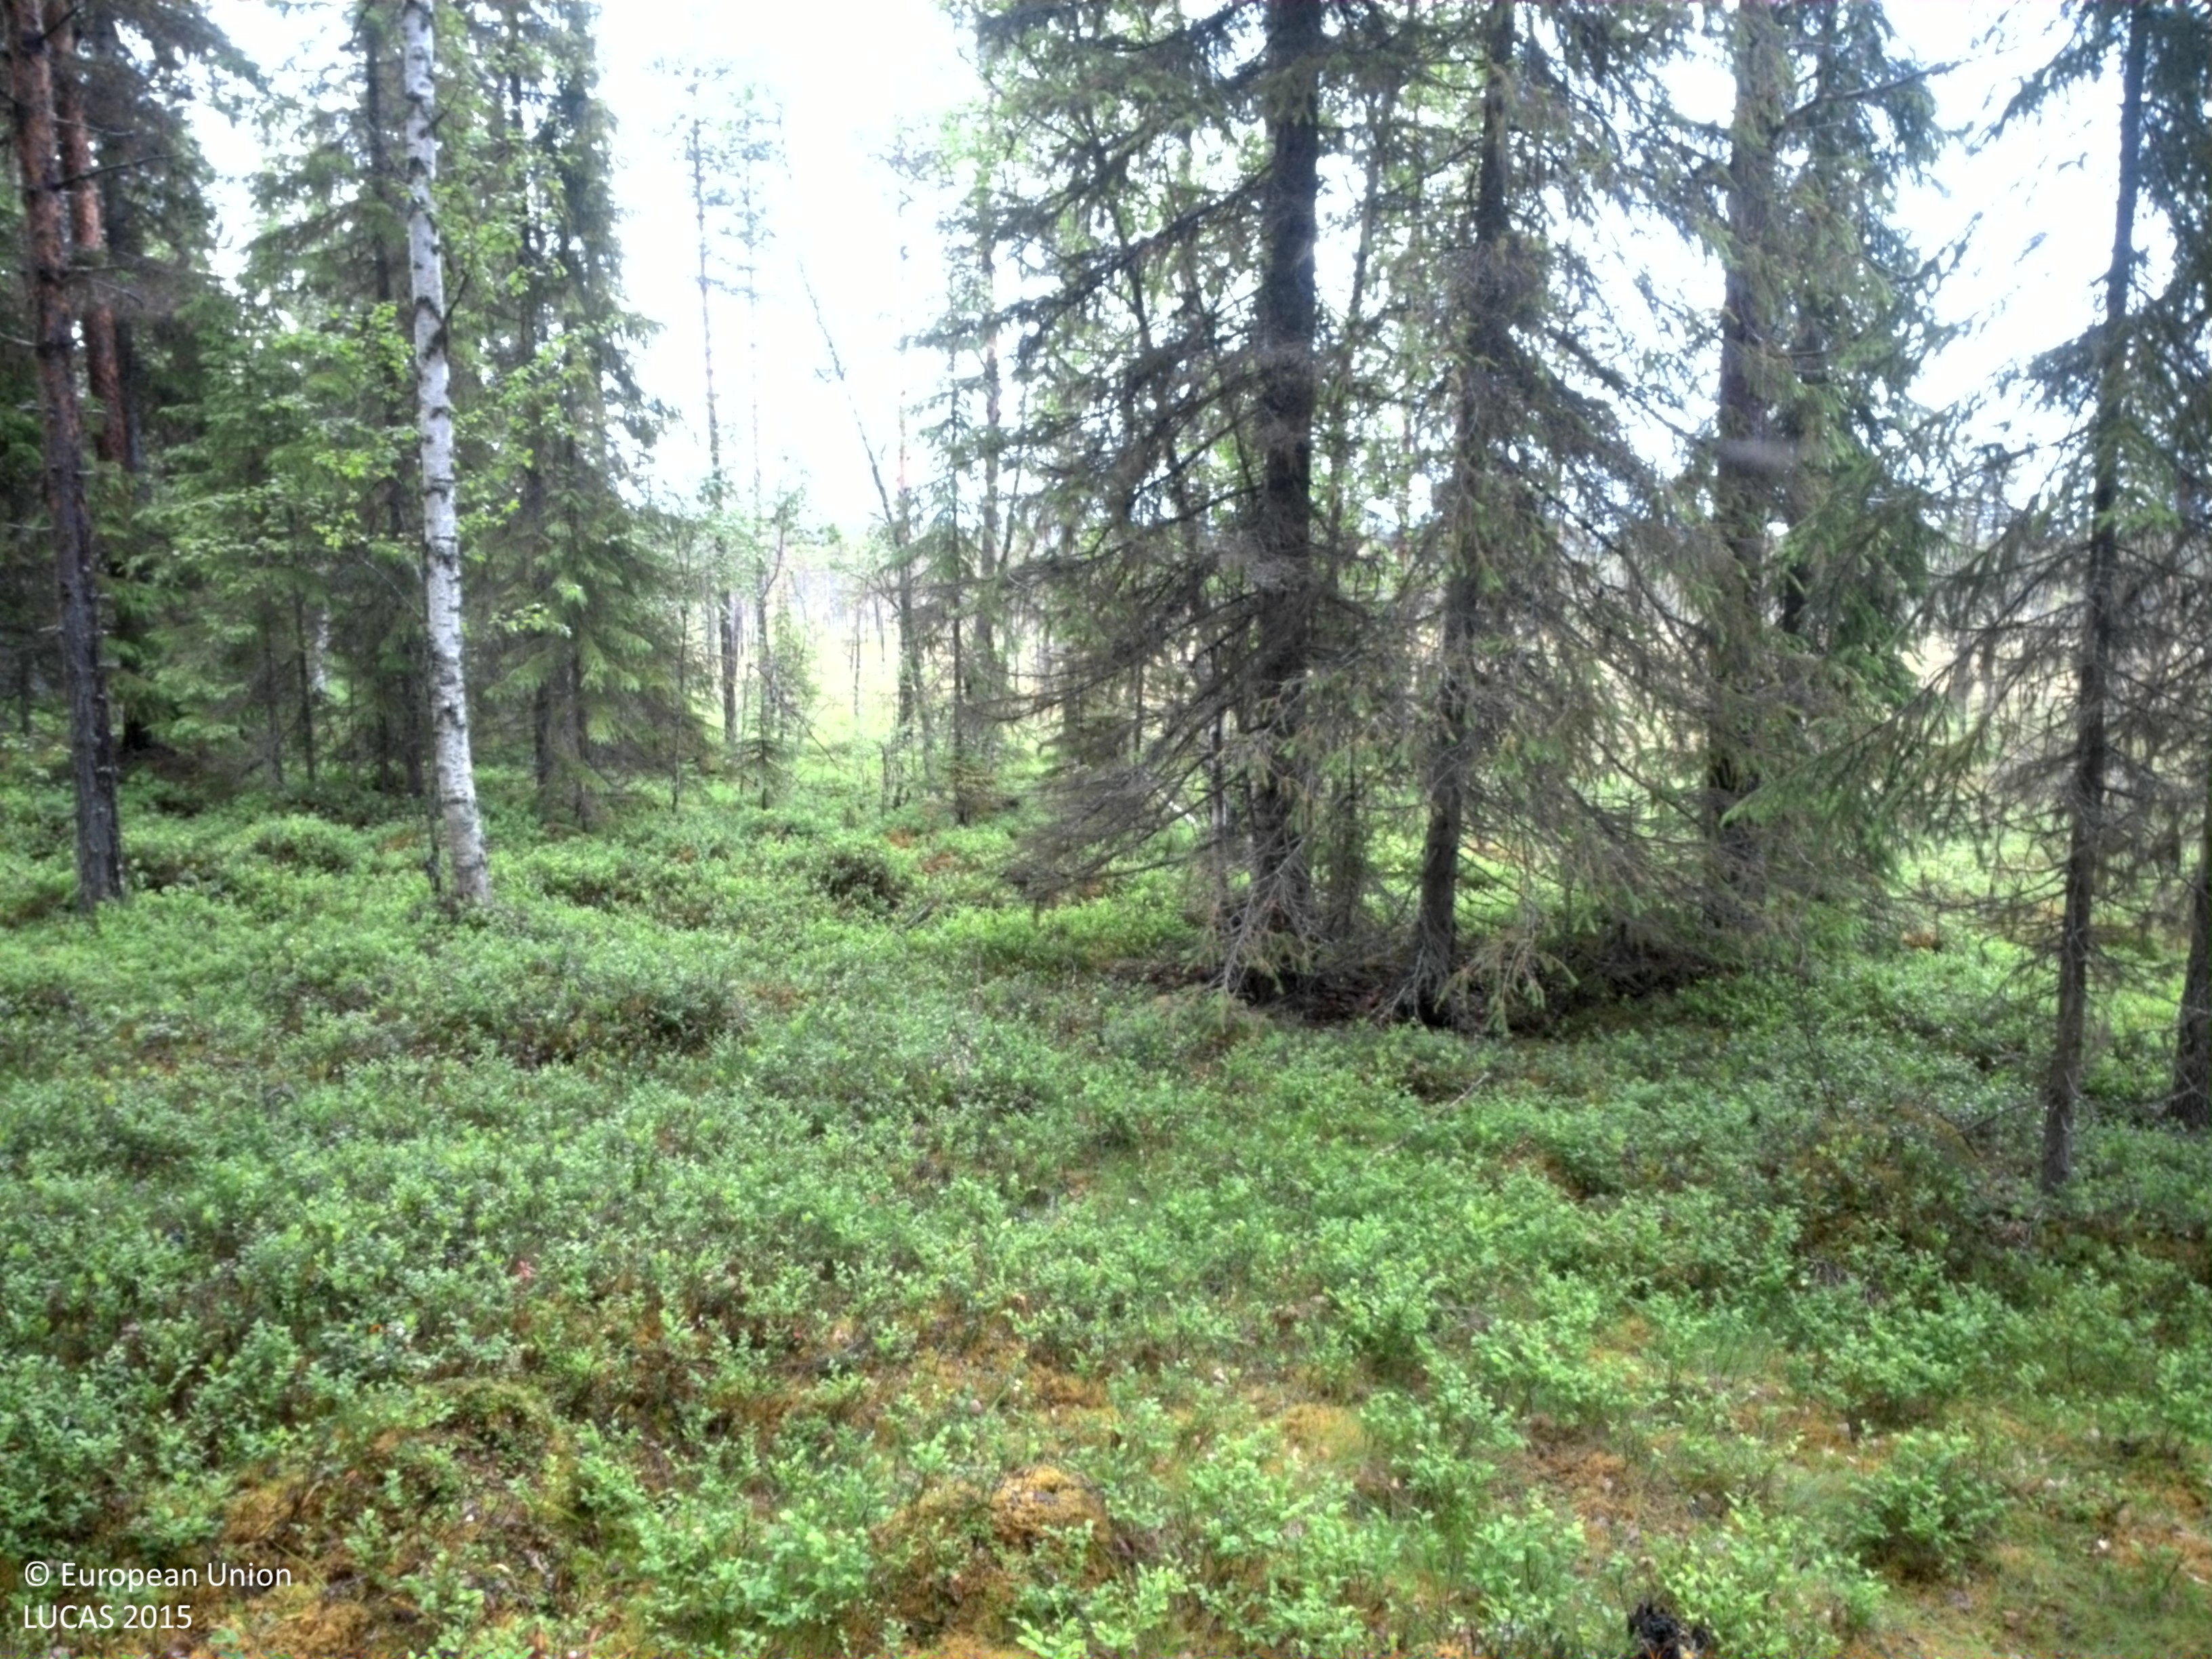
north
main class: Woodland
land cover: Pine dominated coniferous woodland
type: boreal forest
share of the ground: 50 - 75 %
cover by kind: coniferous forest trees 65 %, shrubs 20 %, broadleaved forest trees 10 %, lichens and mosses 5 %
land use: Forestry
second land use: Amenities, museums, leisure
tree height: > 5 m
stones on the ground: 25 - 50 %
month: July
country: SE
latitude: 64.6365
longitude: 18.2732
